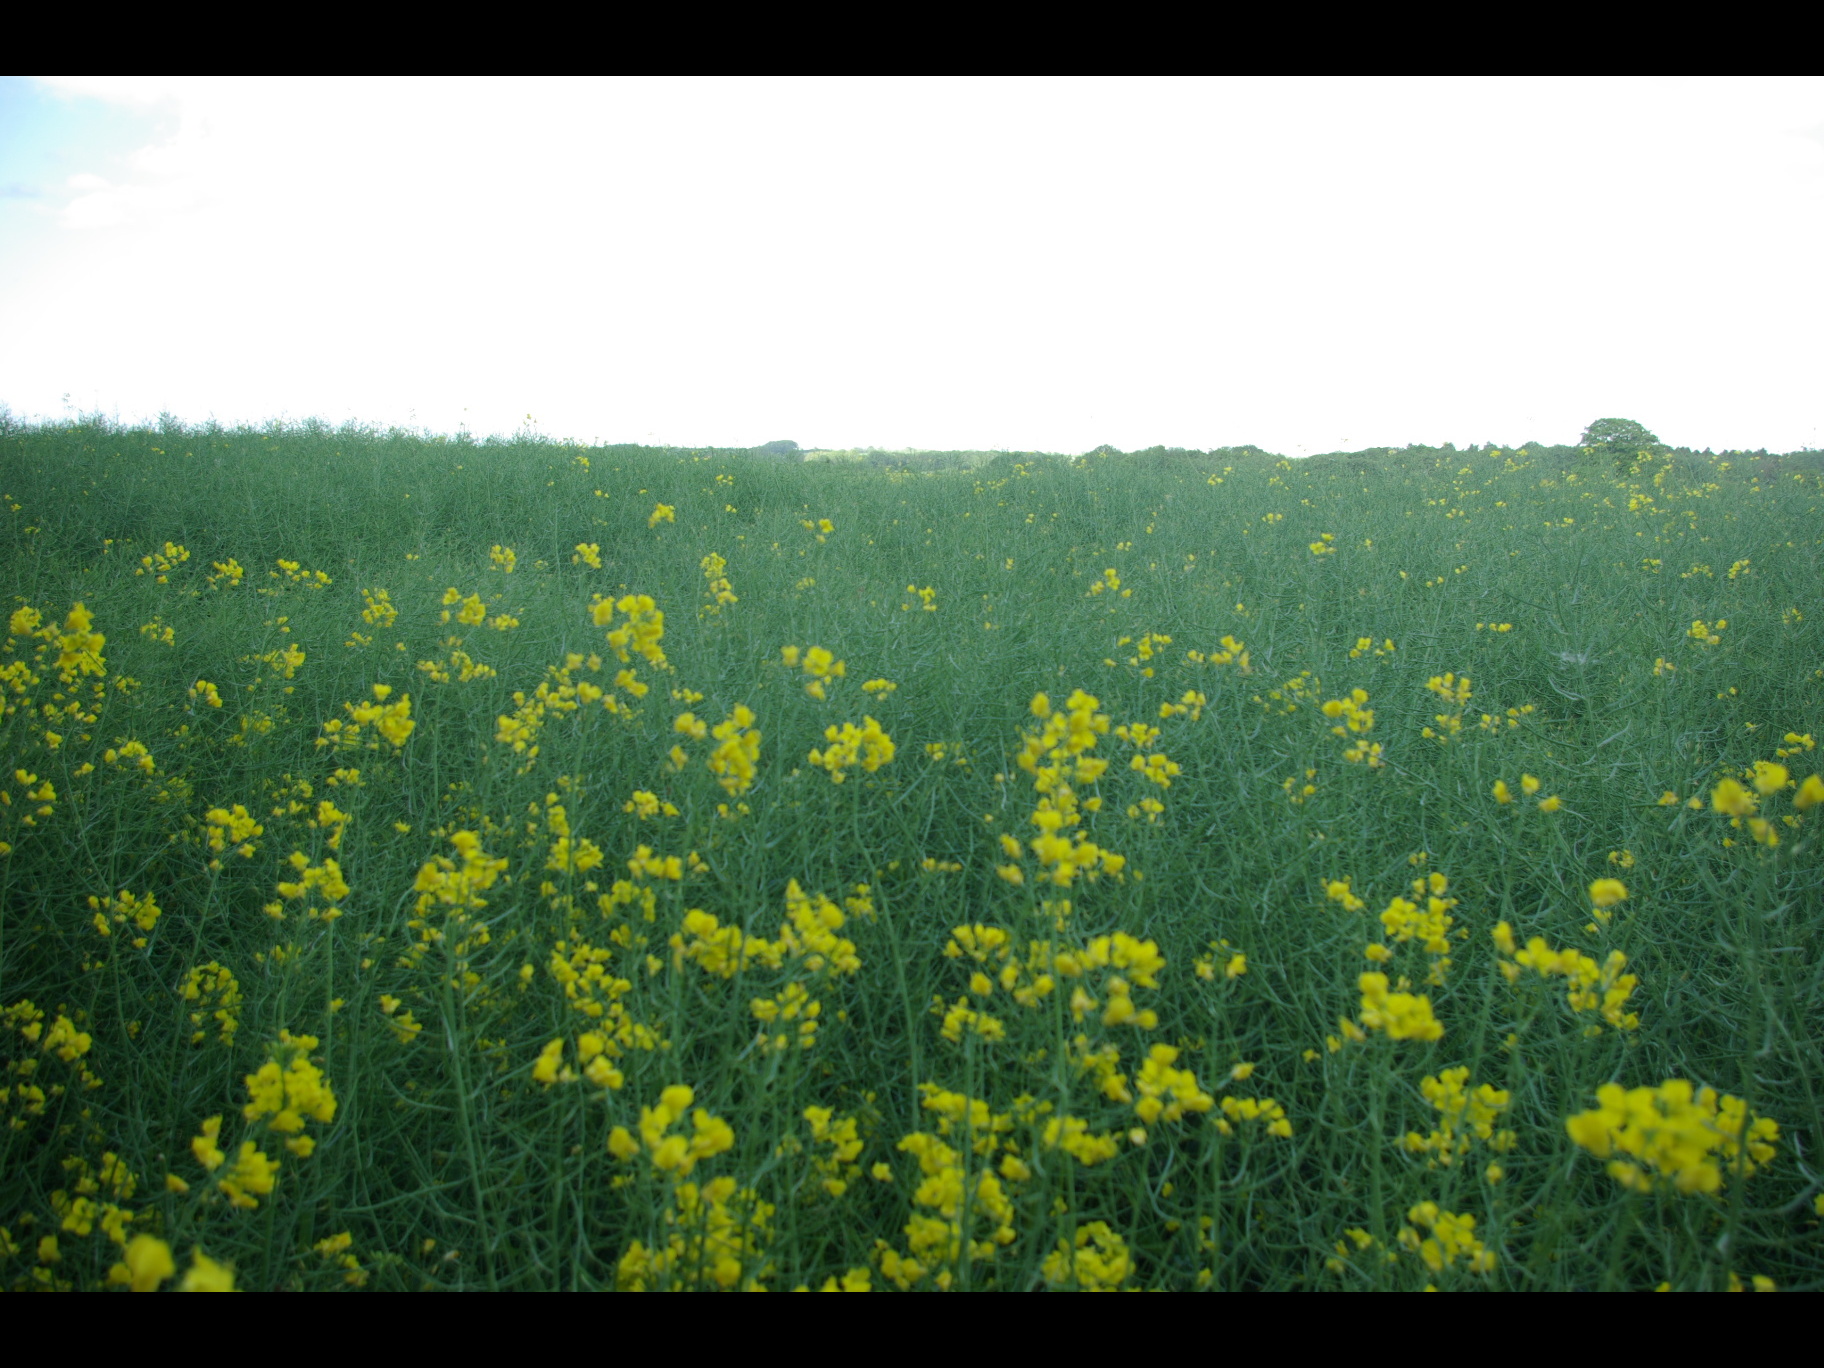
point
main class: Cropland
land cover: Rape and turnip rape
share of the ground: > 75 %
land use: Agriculture (excluding fallow land and kitchen gardens)
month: June
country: DE
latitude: 54.2809
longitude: 10.6293
